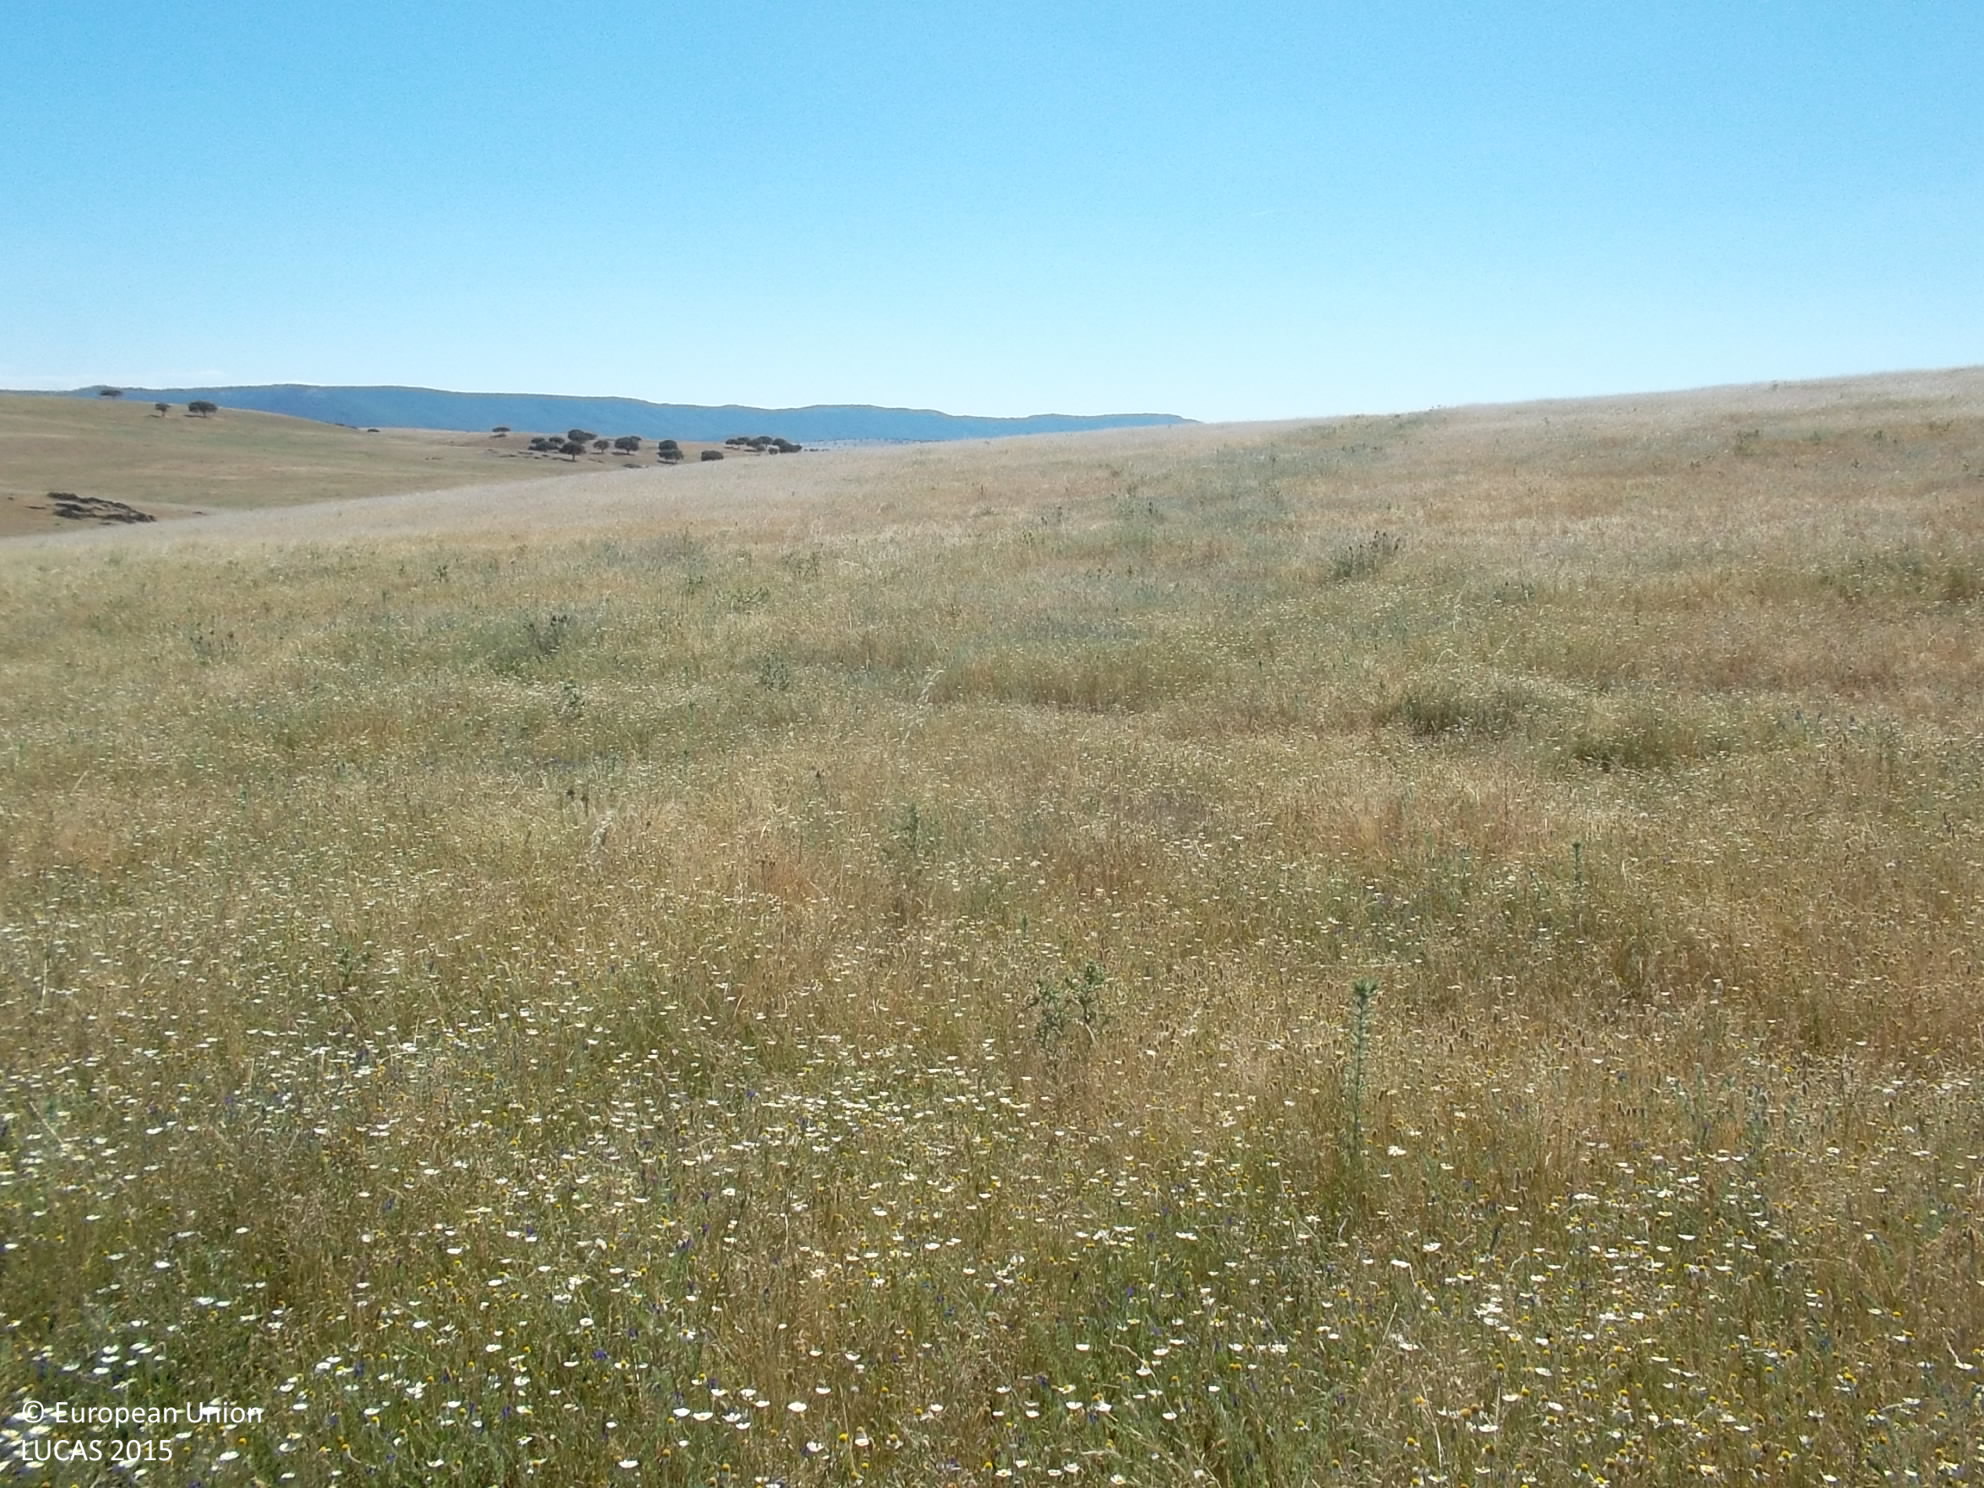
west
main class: Grassland
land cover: Grassland without tree/shrub cover
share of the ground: > 75 %
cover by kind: herbaceous plants 100 %
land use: Agriculture (excluding fallow land and kitchen gardens)
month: May
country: ES
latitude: 38.6311
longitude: -4.3917
